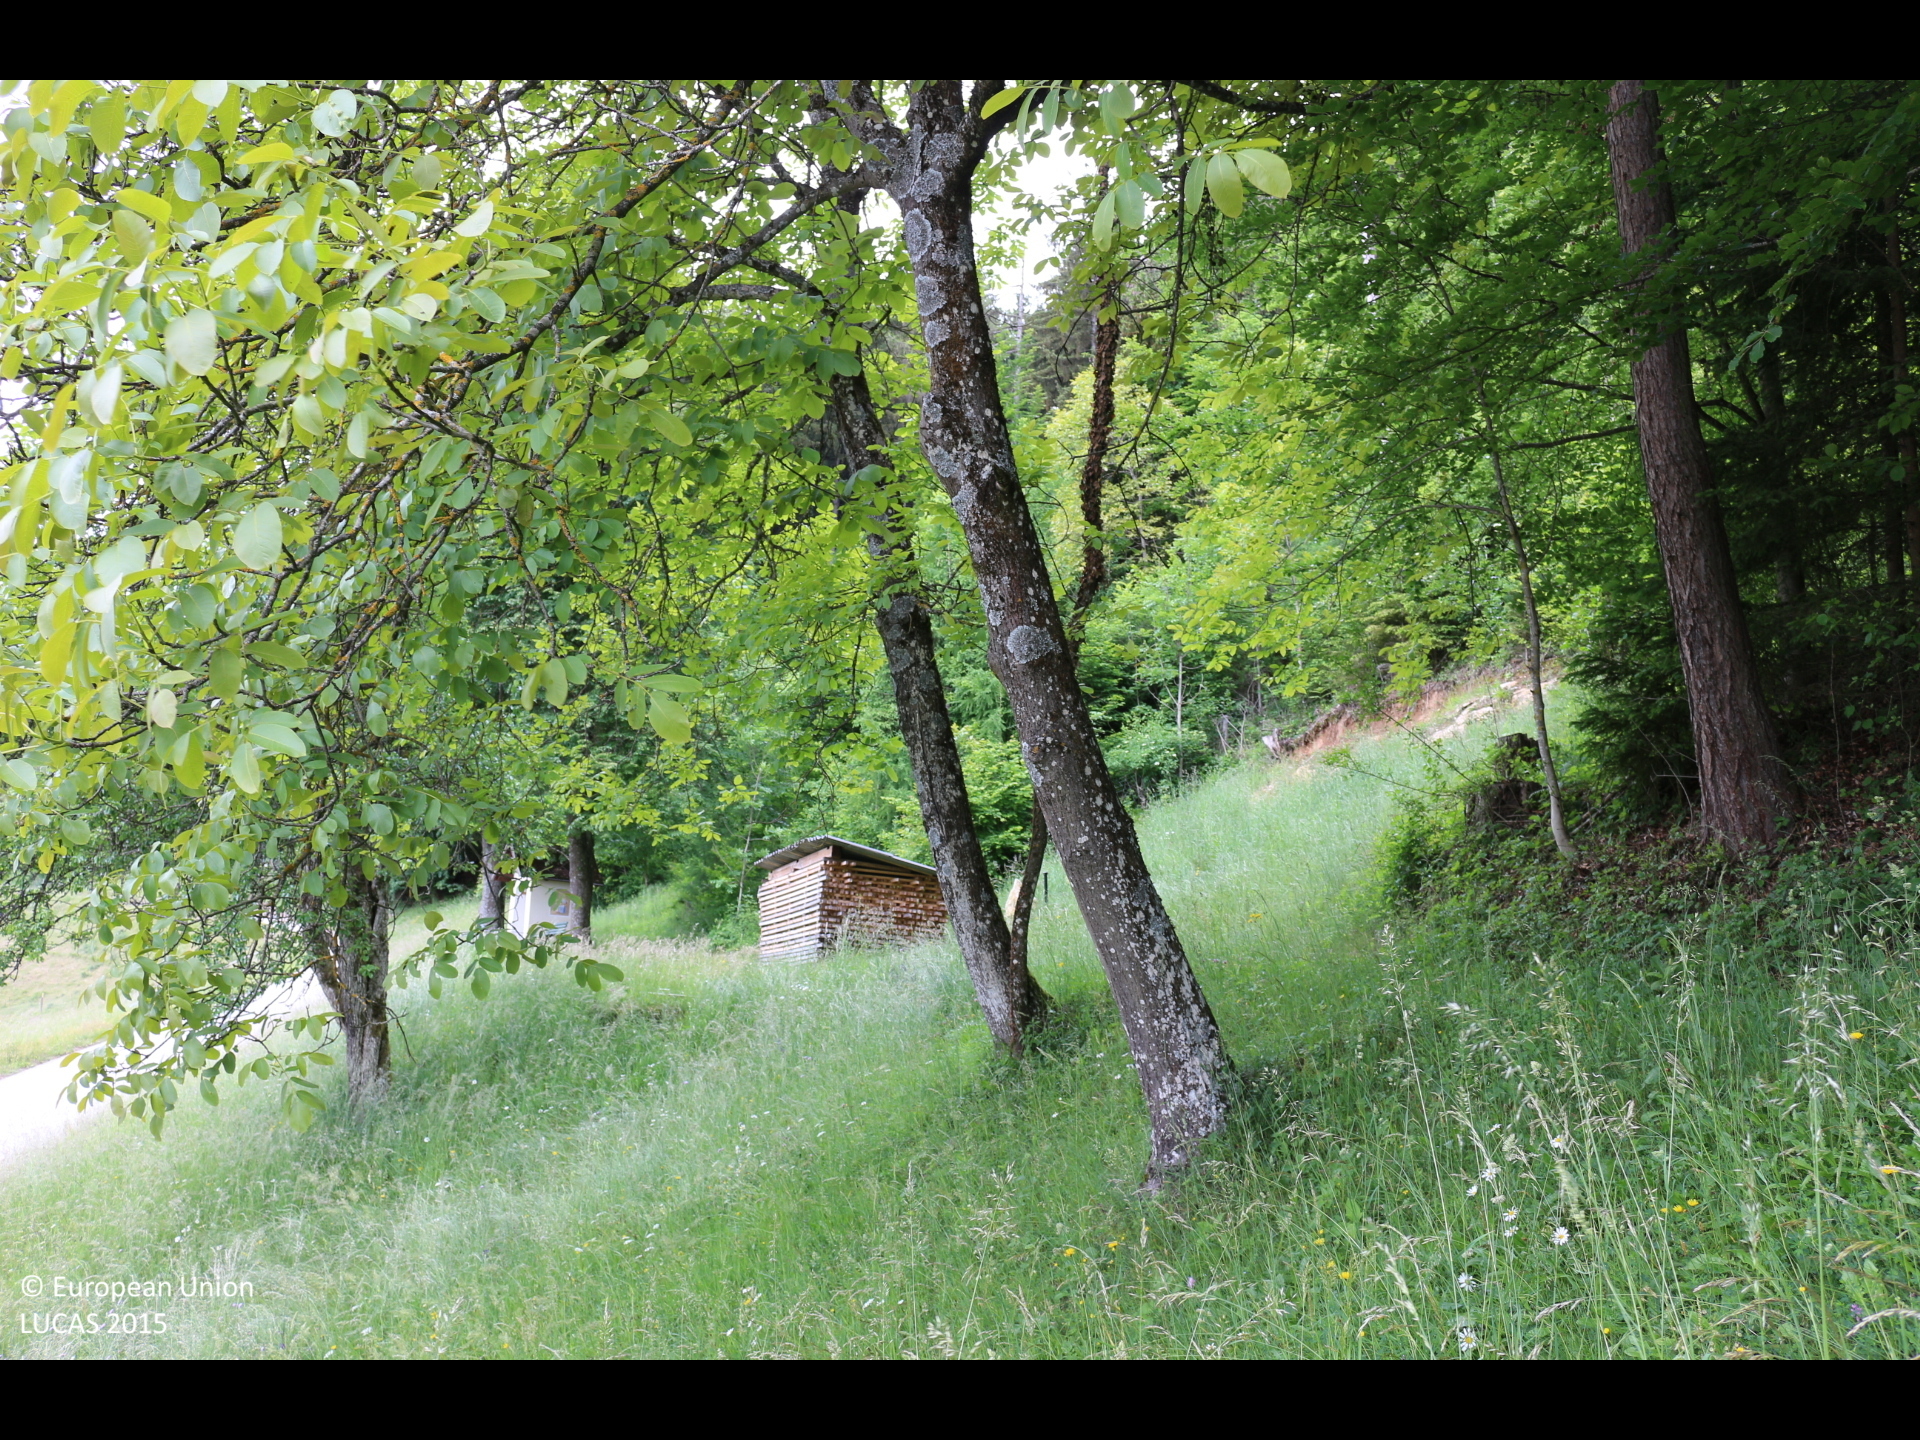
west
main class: Grassland
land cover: Grassland with sparse tree/shrub cover
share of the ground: > 75 %
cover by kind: herbaceous plants 90 %, broadleaved forest trees 5 %, shrubs 5 %
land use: Agriculture (excluding fallow land and kitchen gardens)
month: May
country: AT
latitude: 46.6992
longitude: 14.6930
